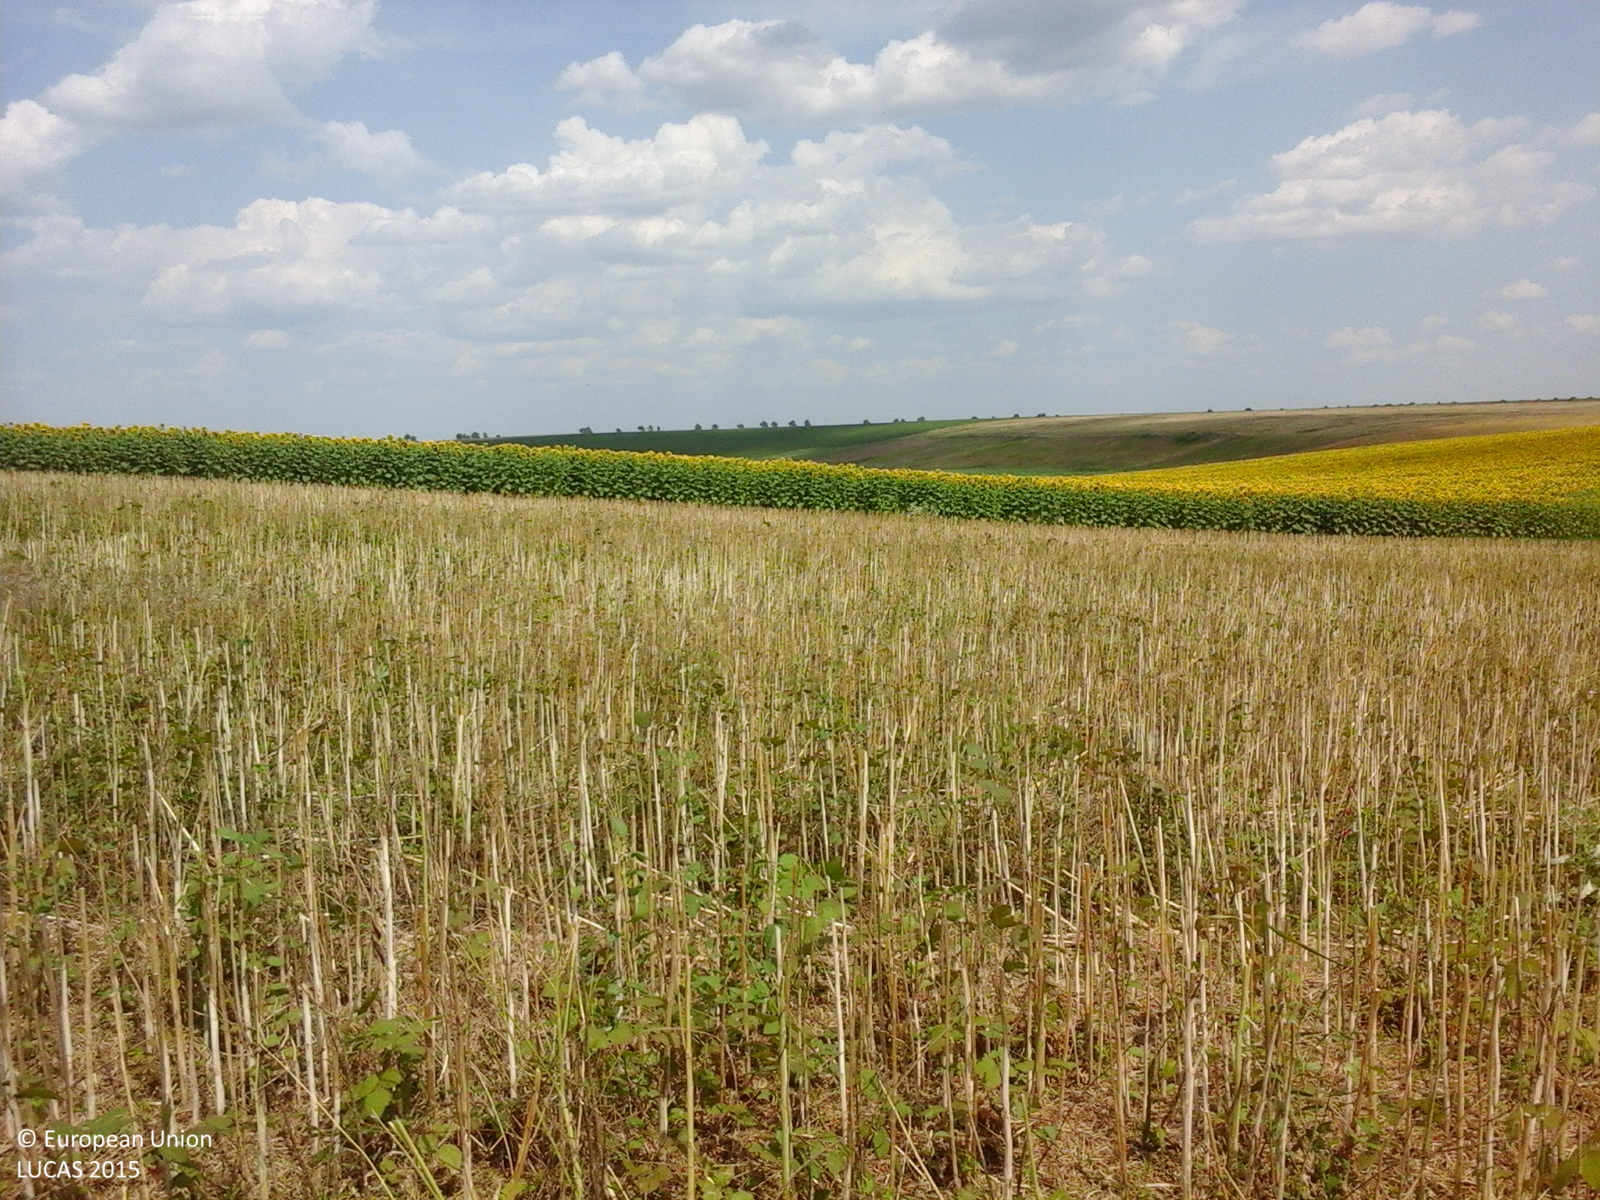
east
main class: Cropland
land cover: Rape and turnip rape
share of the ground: < 10 %
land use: Agriculture (excluding fallow land and kitchen gardens)
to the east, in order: Rape and turnip rape; Grass margins; Tracks; Grass margins; Sunflower; Common wheat
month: June
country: RO
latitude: 44.1186
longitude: 26.2884
